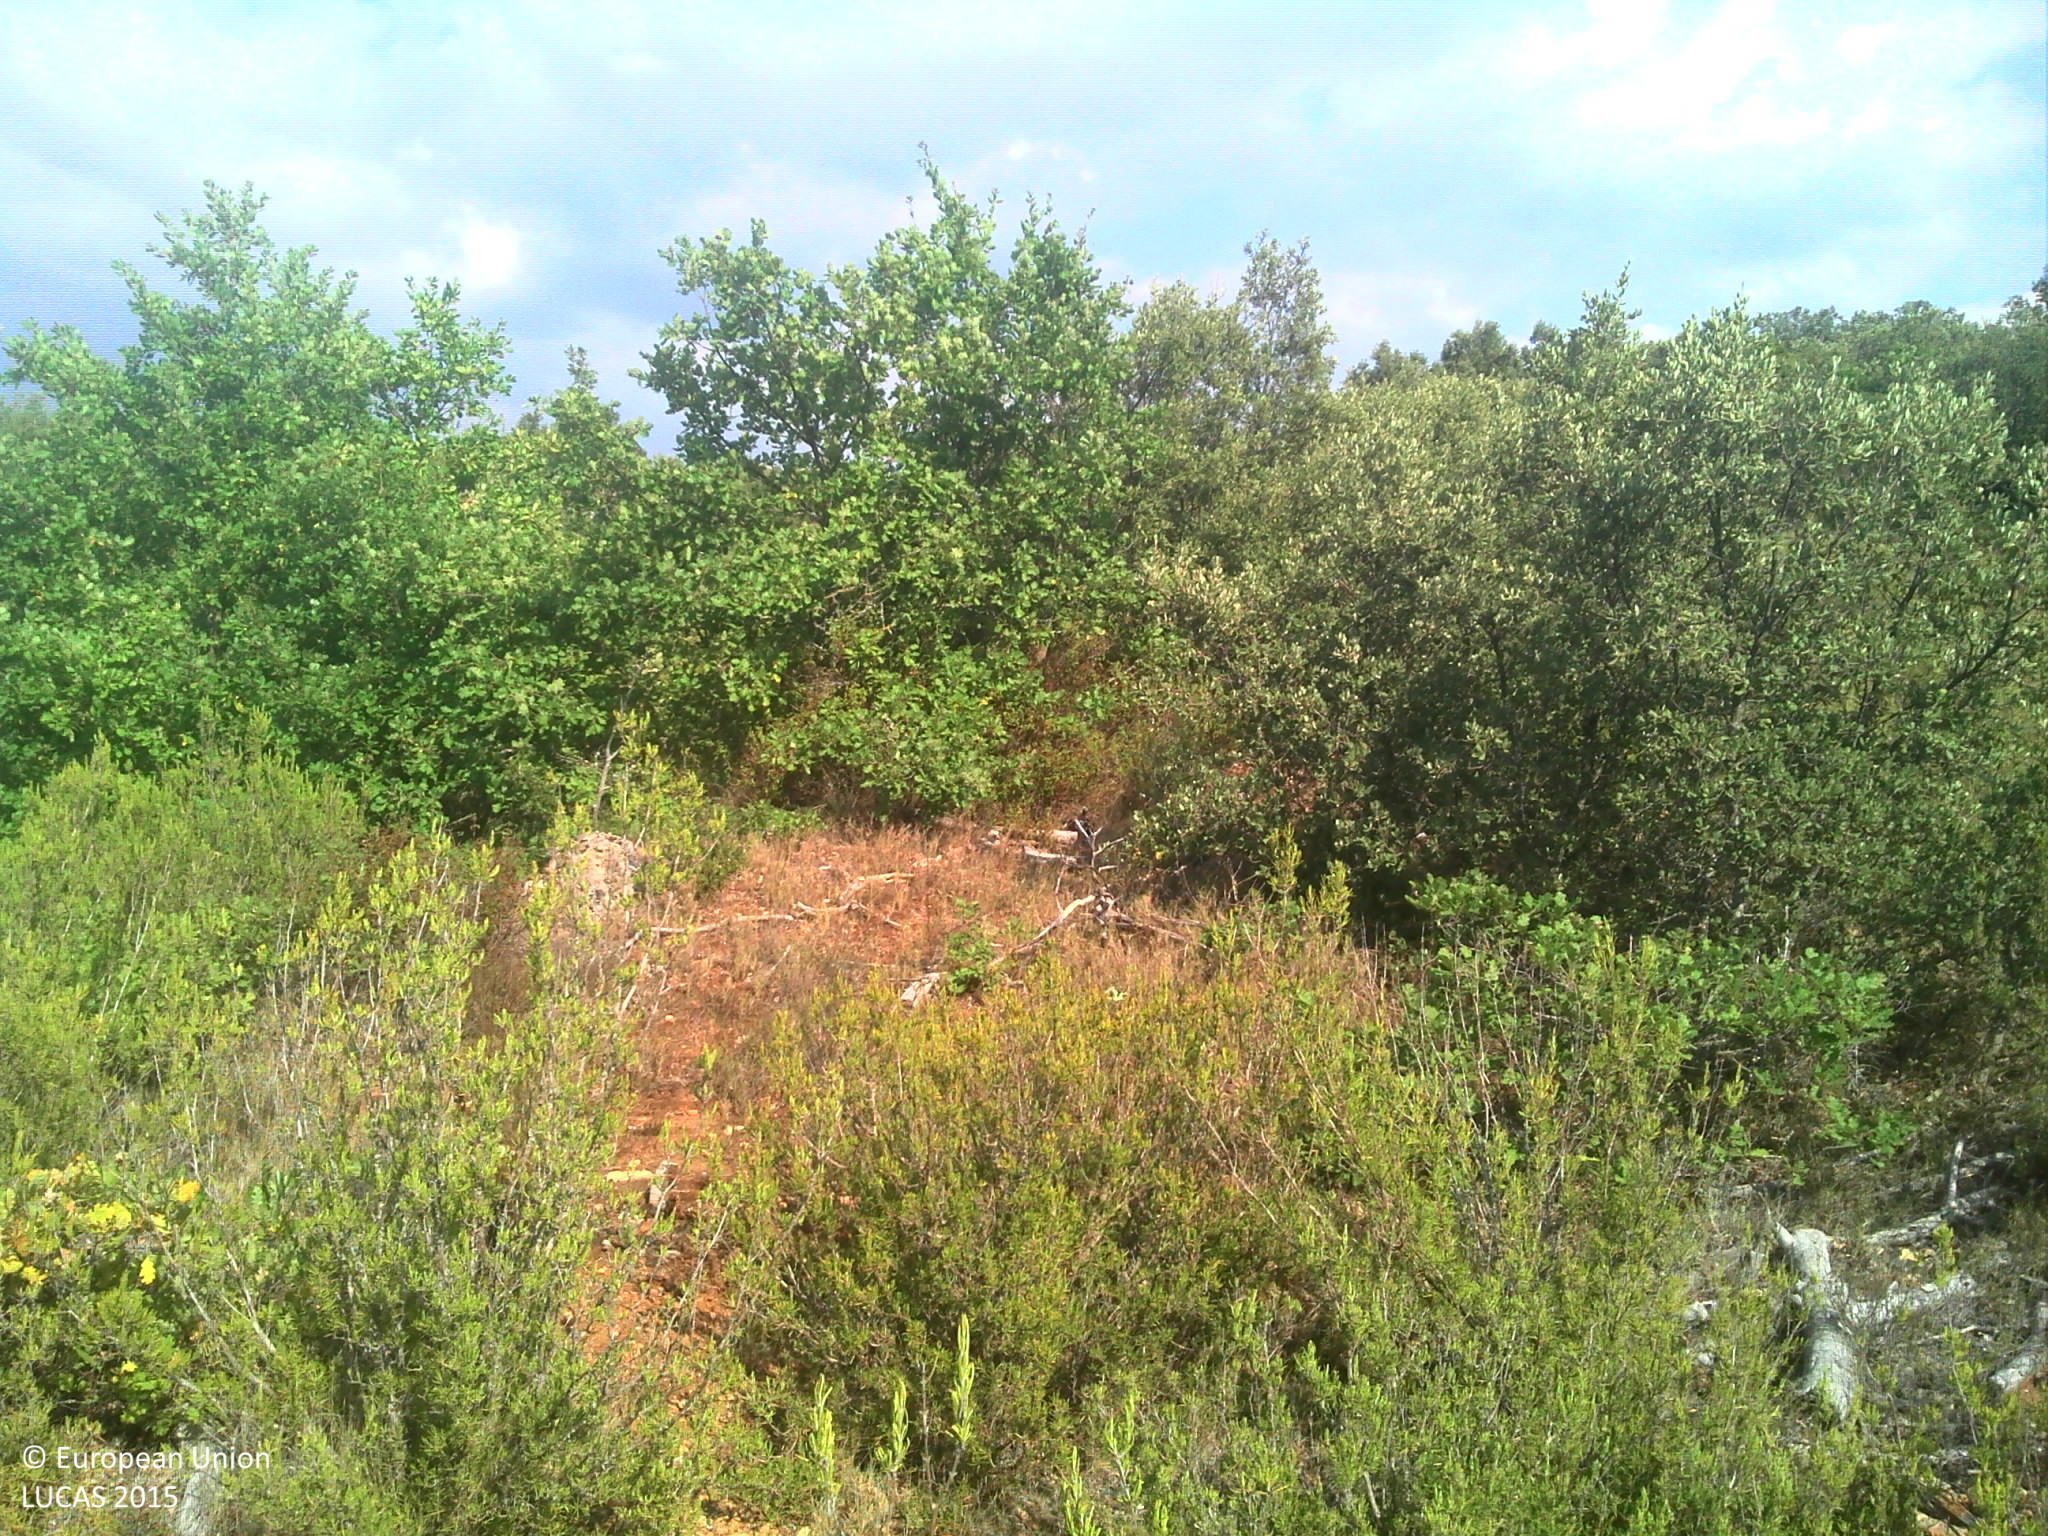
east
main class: Shrubland
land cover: Shrubland with sparse tree cover
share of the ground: > 75 %
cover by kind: shrubs 50 %, herbaceous plants 30 %, unconsolidated bare surface 10 %, broadleaved forest trees 5 %, lichens and mosses 5 %
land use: Forestry
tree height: < 5 m
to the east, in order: Shrubland with sparse tree cover; Broadleaved woodland; Tracks; Shrubland with sparse tree cover; Shrubland without tree cover; Dry stone walls; Shrubland without tree cover; Rock outcrops; Shrubland with sparse tree cover; Shrubland without tree cover; Tracks; Shrubland without tree cover; Rocks and stones; Tracks; Shrubland without tree cover; Broadleaved woodland; Grassland with sparse tree/shrub cover; Rock outcrops; Grassland with sparse tree/shrub cover; Broadleaved woodland; Grassland without tree/shrub cover; Broadleaved woodland; Artificial constructions; Grassland with sparse tree/shrub cover; Tracks; Broadleaved woodland; Grassland with sparse tree/shrub cover
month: August
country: FR
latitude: 43.6264
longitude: 5.6344
